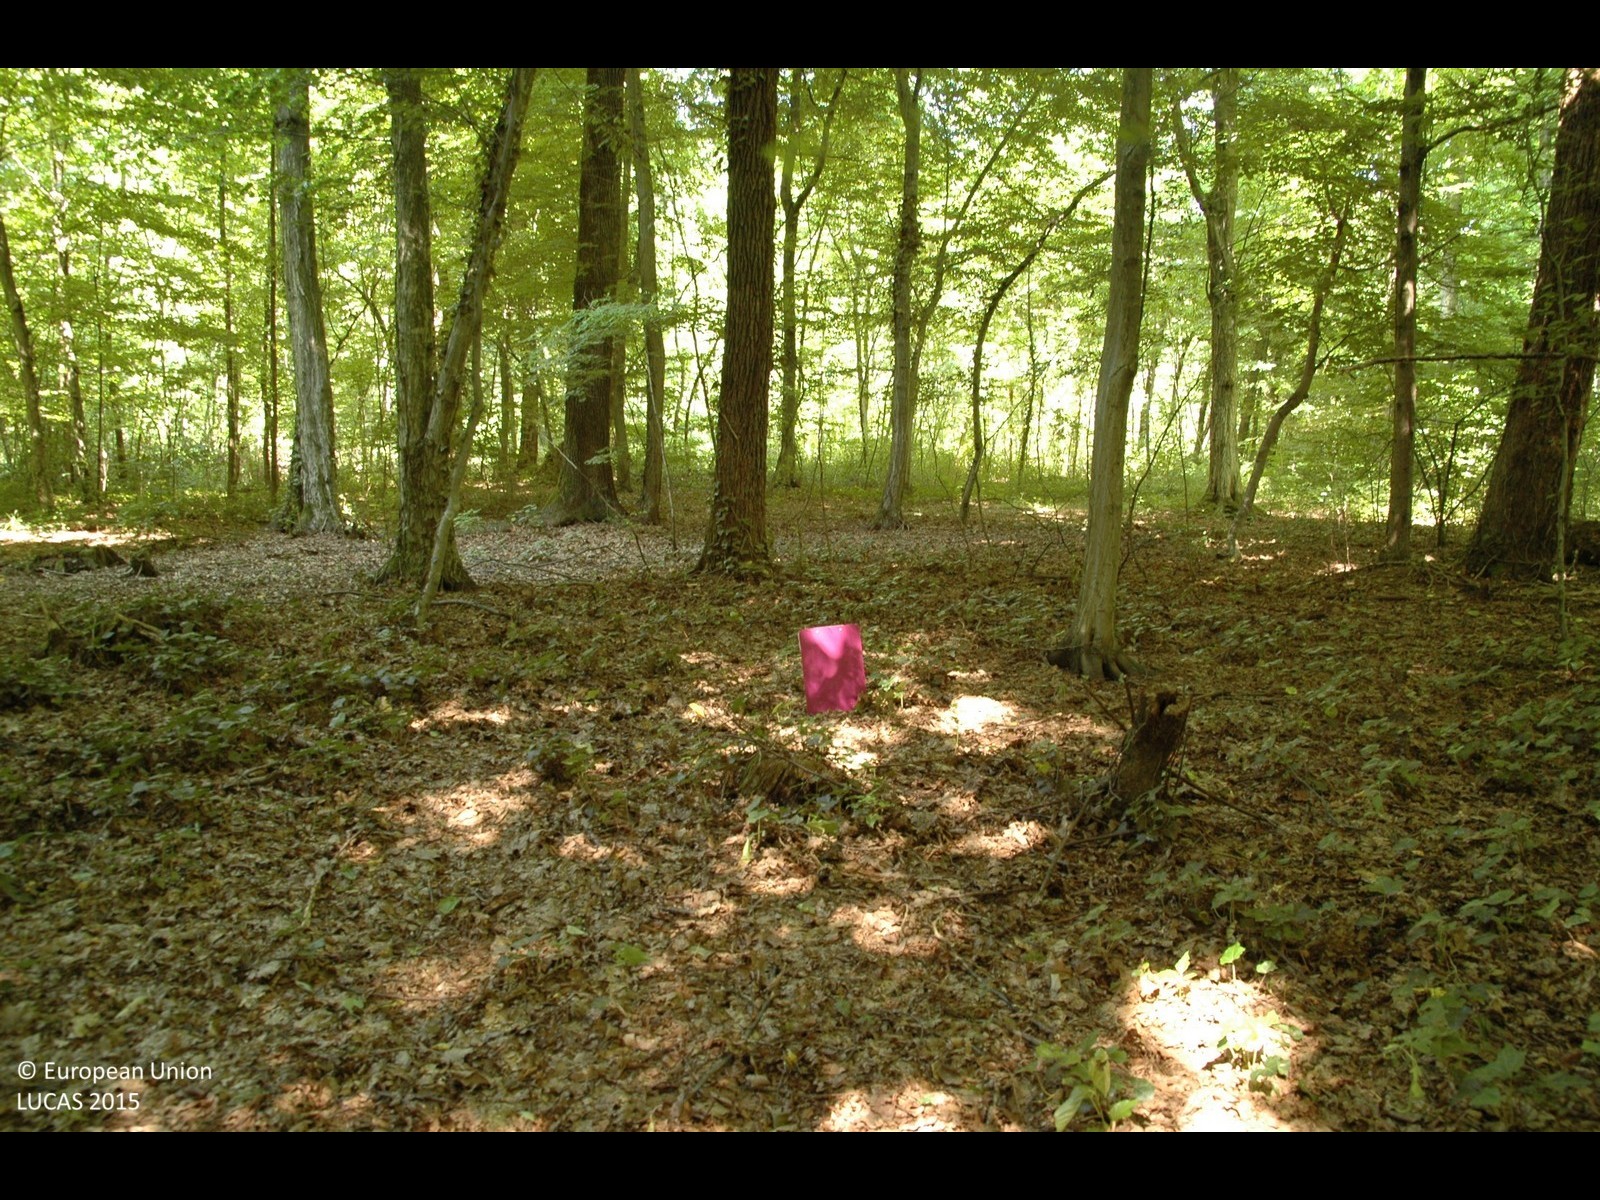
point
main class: Woodland
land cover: Broadleaved woodland
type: mesophytic deciduous forest
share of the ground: > 75 %
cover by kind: broadleaved forest trees 90 %, shrubs 5 %, herbaceous plants 5 %
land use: Forestry
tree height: > 5 m
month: March
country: HR
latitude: 46.3730
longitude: 16.1488
